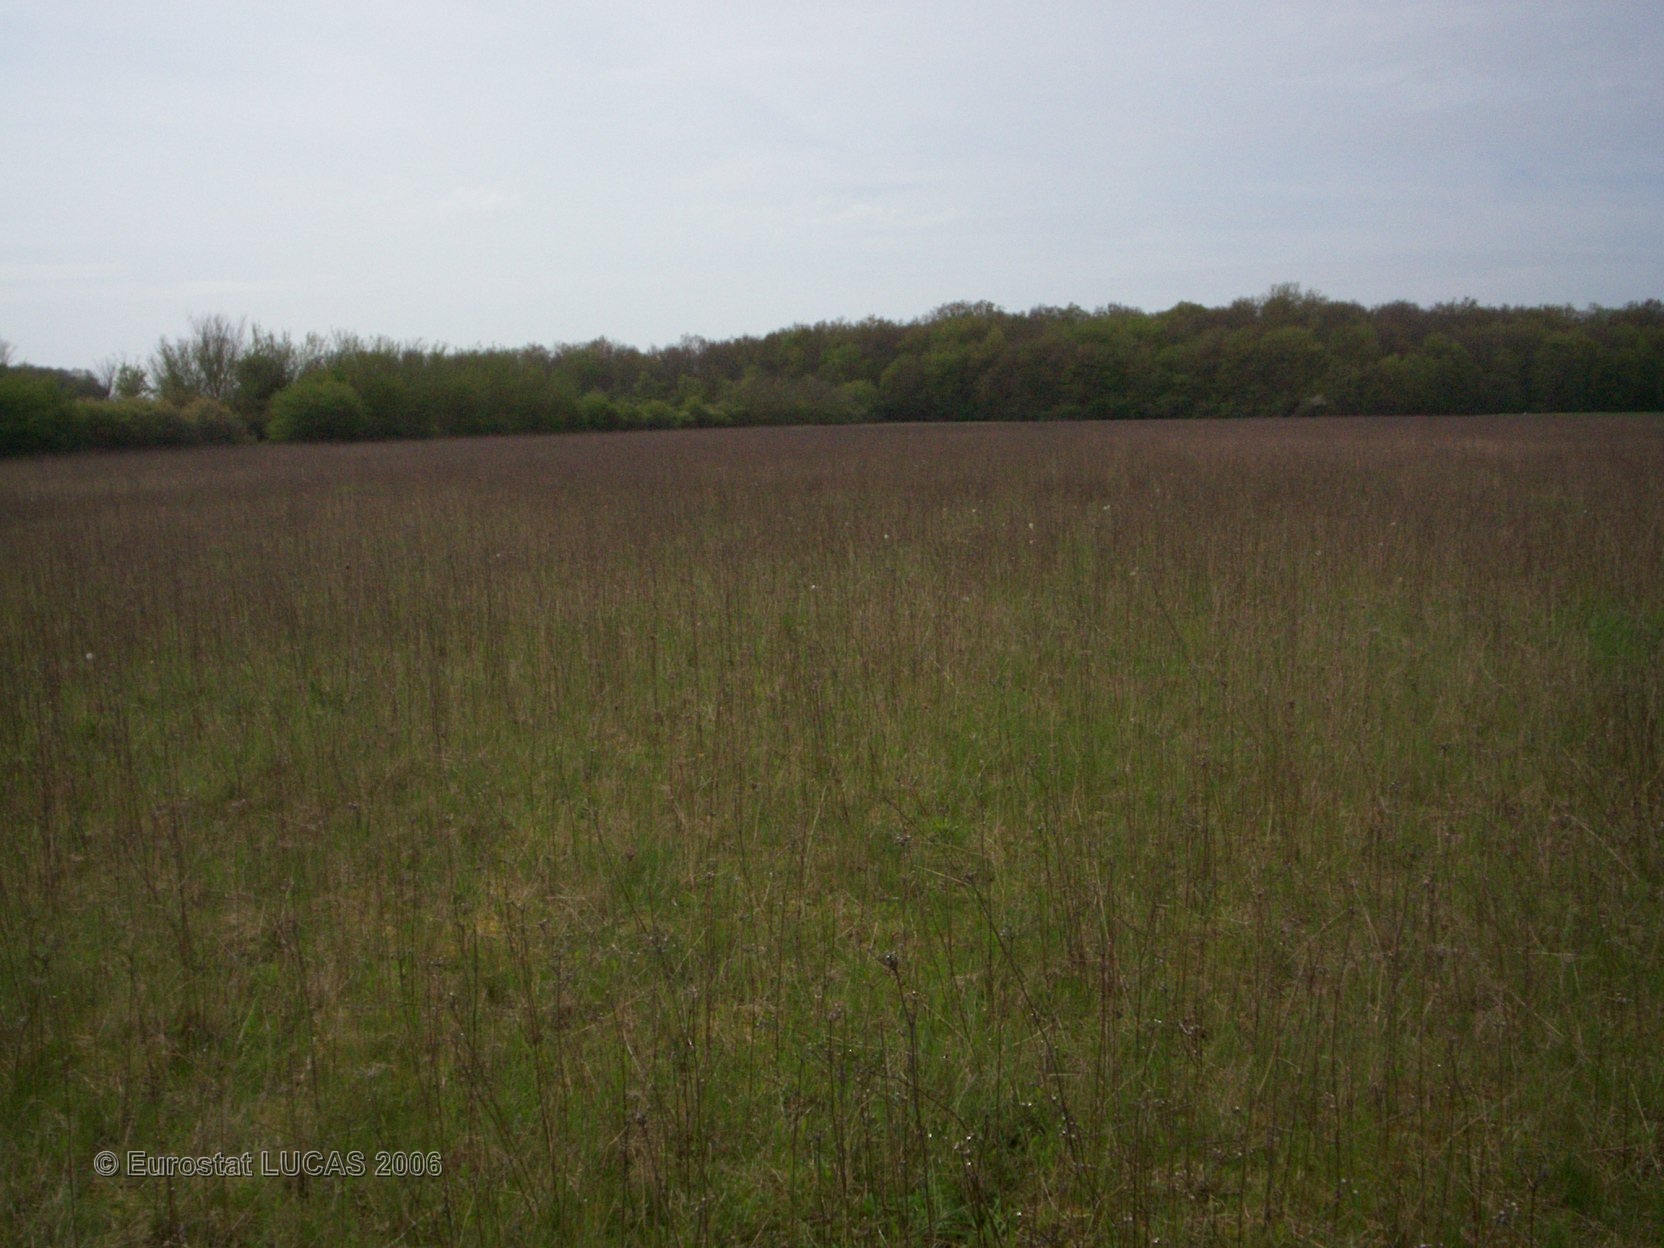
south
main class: Grassland
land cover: Grassland without tree/shrub cover
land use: Fallow land
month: May
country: FR
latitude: 47.2835
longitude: 3.0806
